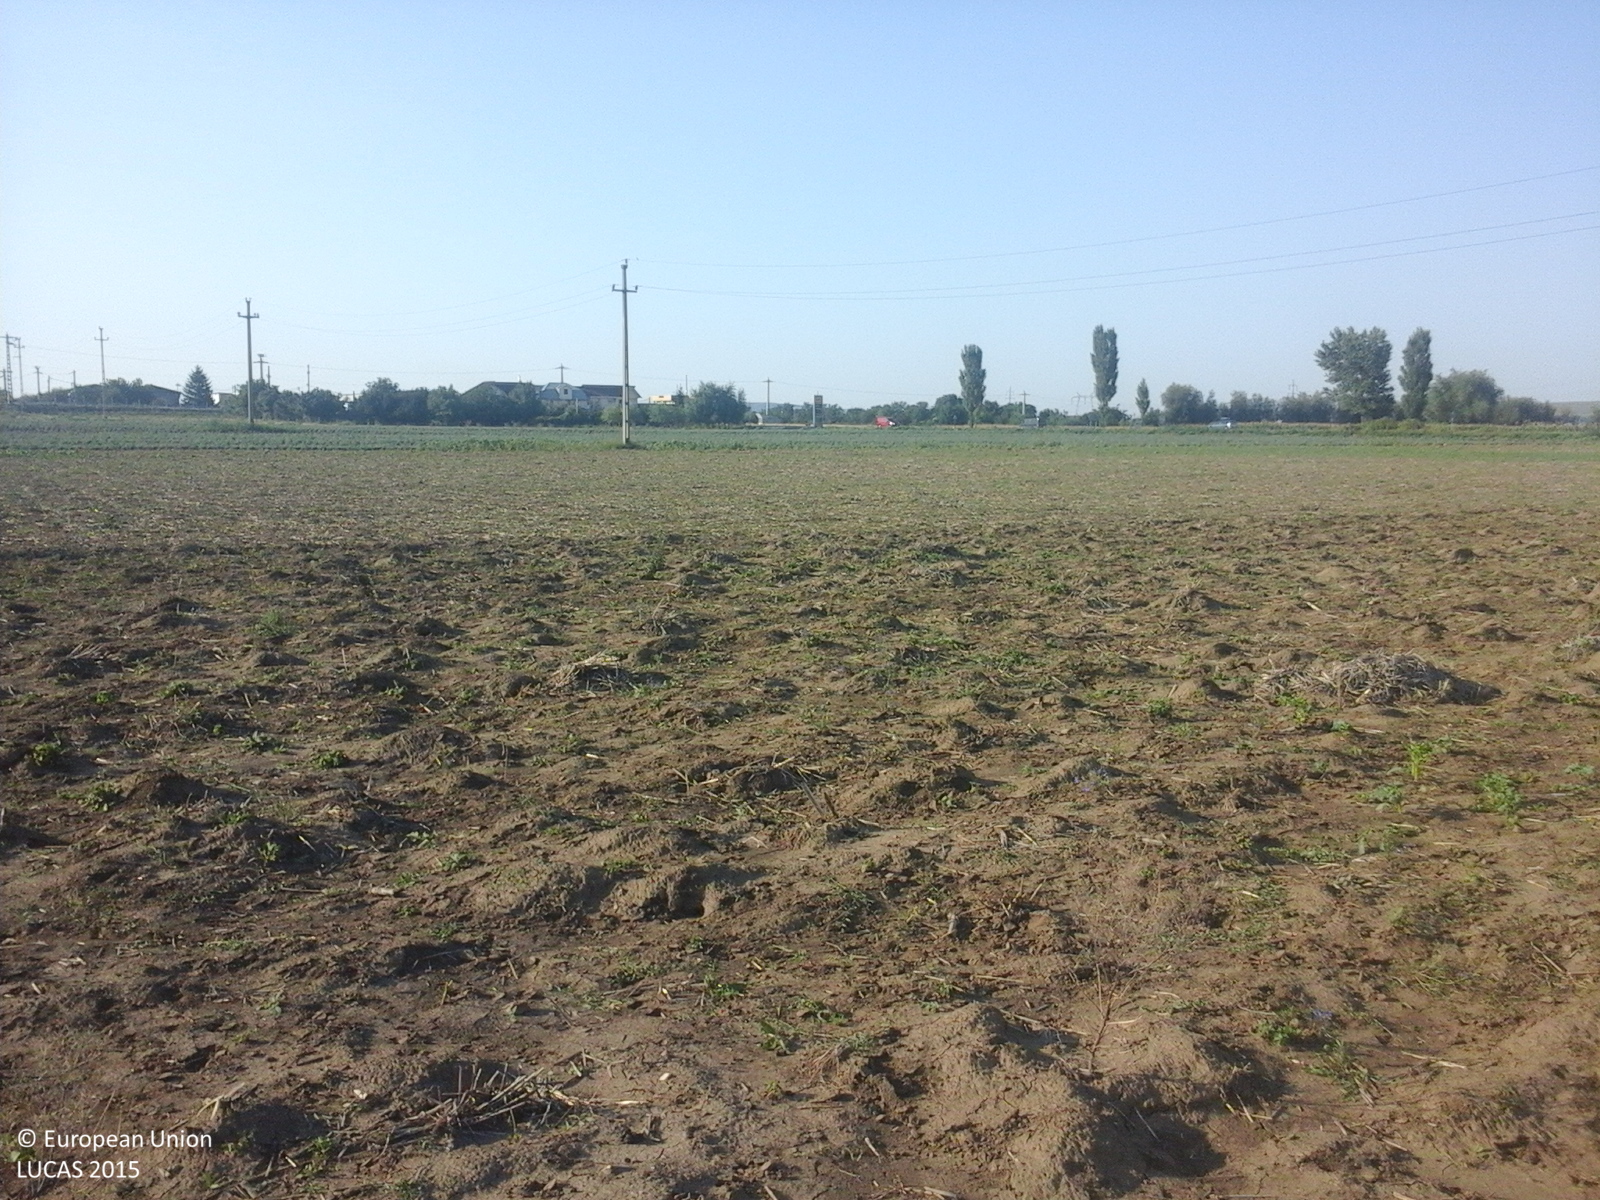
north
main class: Cropland
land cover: Common wheat
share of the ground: < 10 %
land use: Agriculture (excluding fallow land and kitchen gardens)
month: August
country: RO
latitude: 46.3173
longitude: 27.0169
